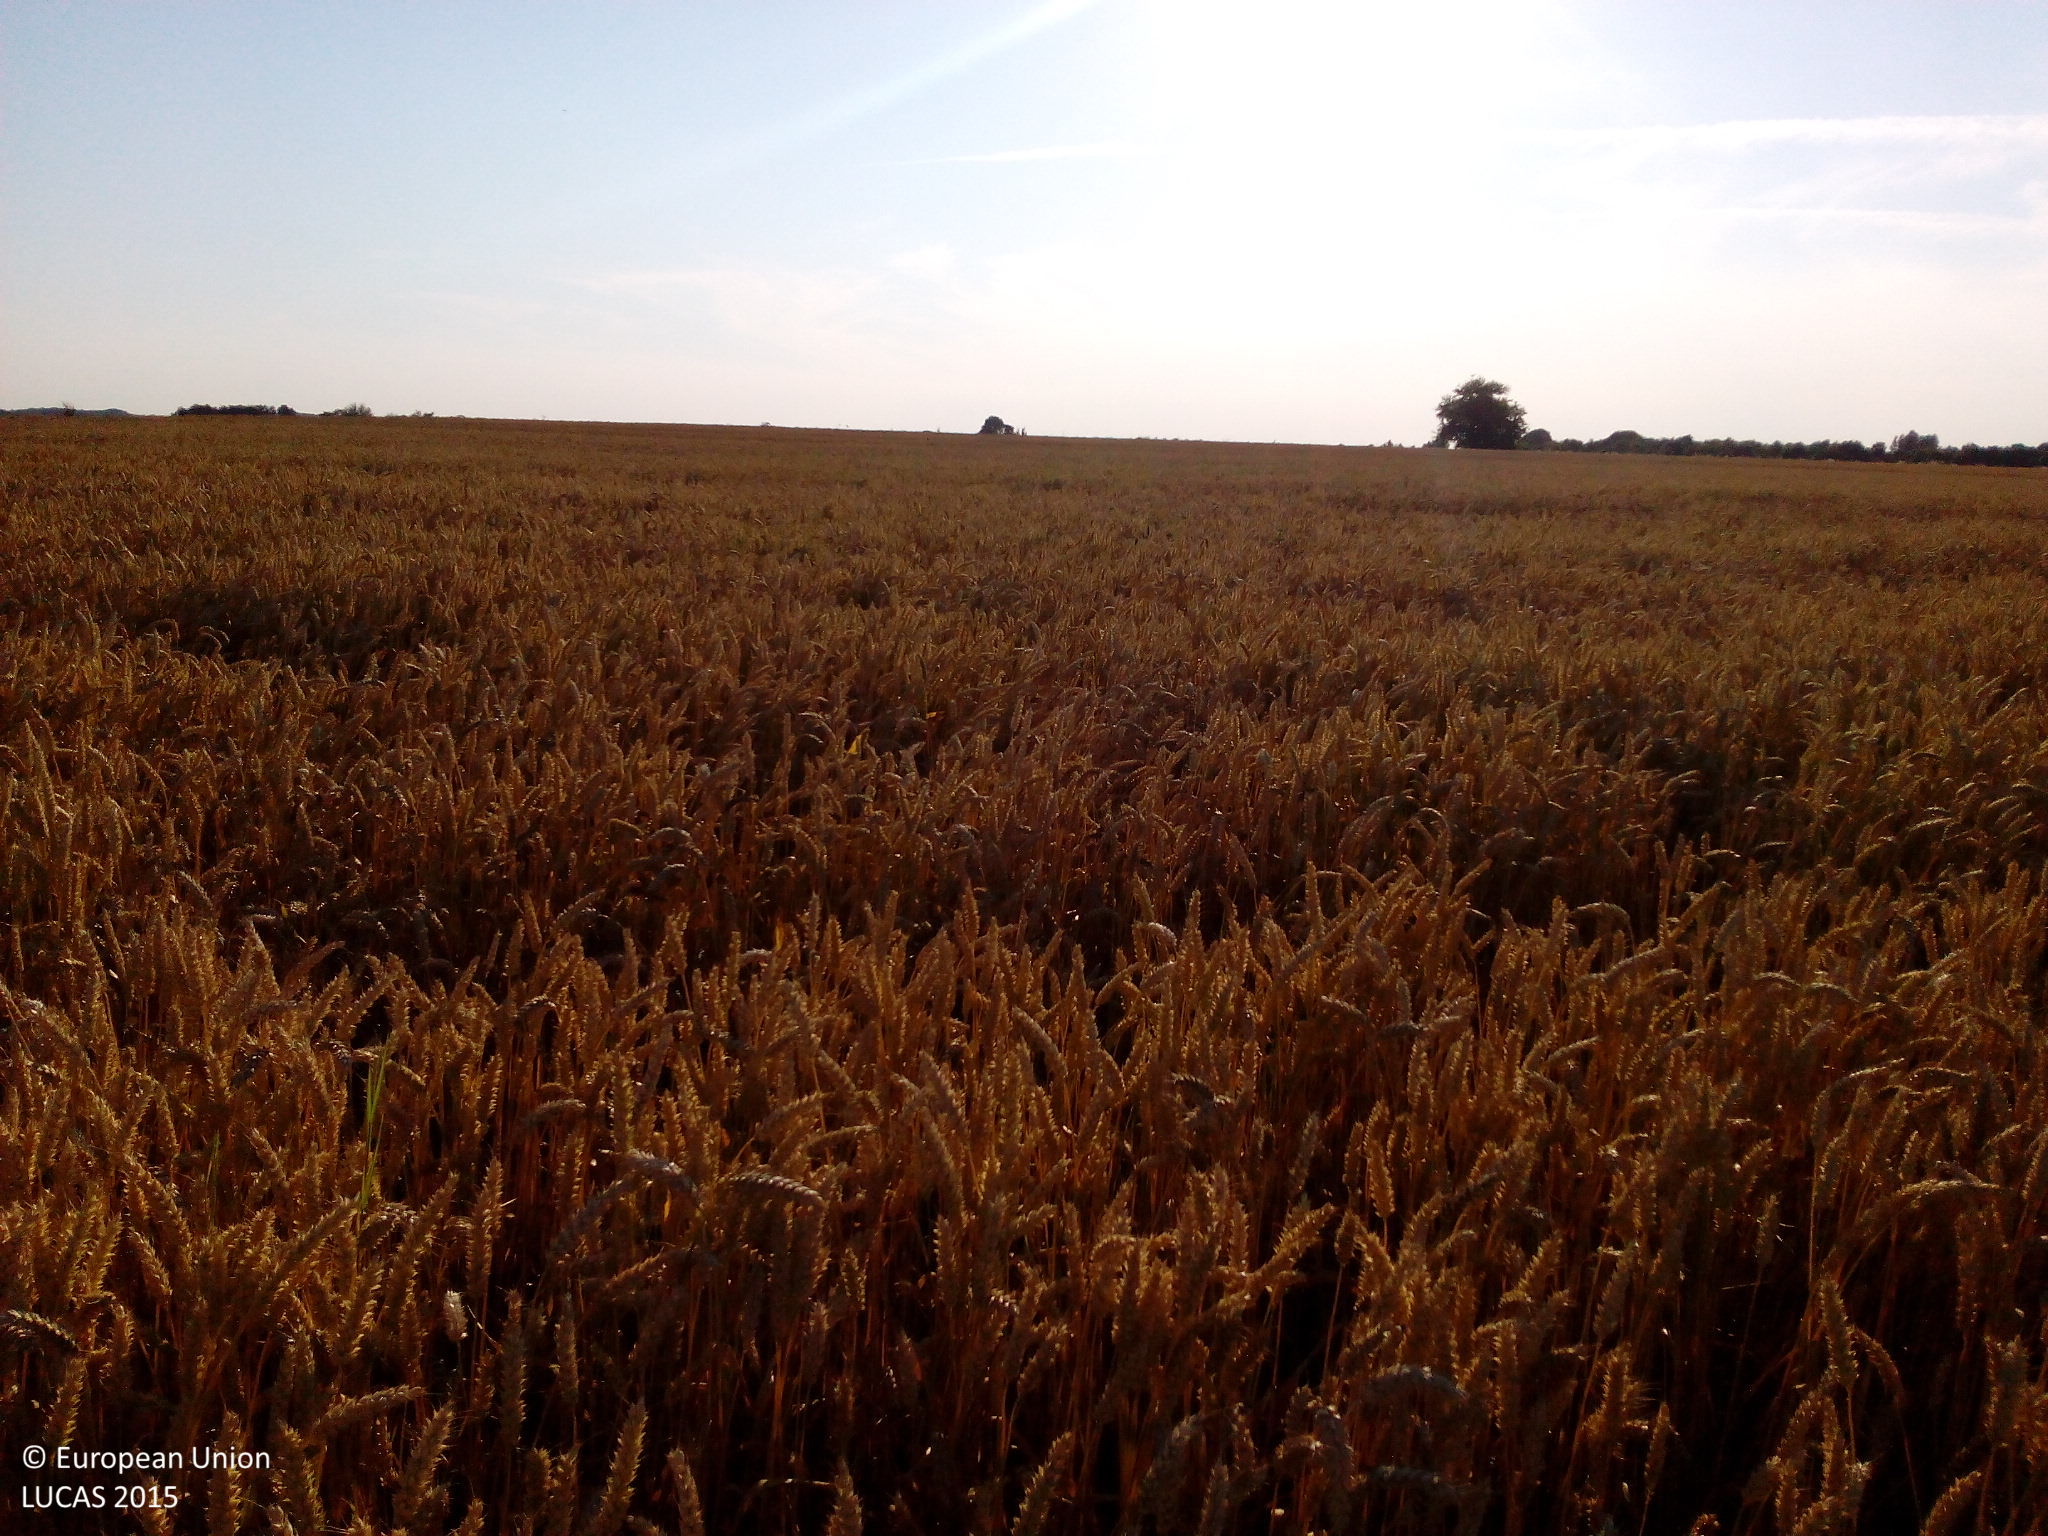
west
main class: Cropland
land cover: Common wheat
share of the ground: > 75 %
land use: Agriculture (excluding fallow land and kitchen gardens)
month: August
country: DK
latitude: 55.6884
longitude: 11.8912
